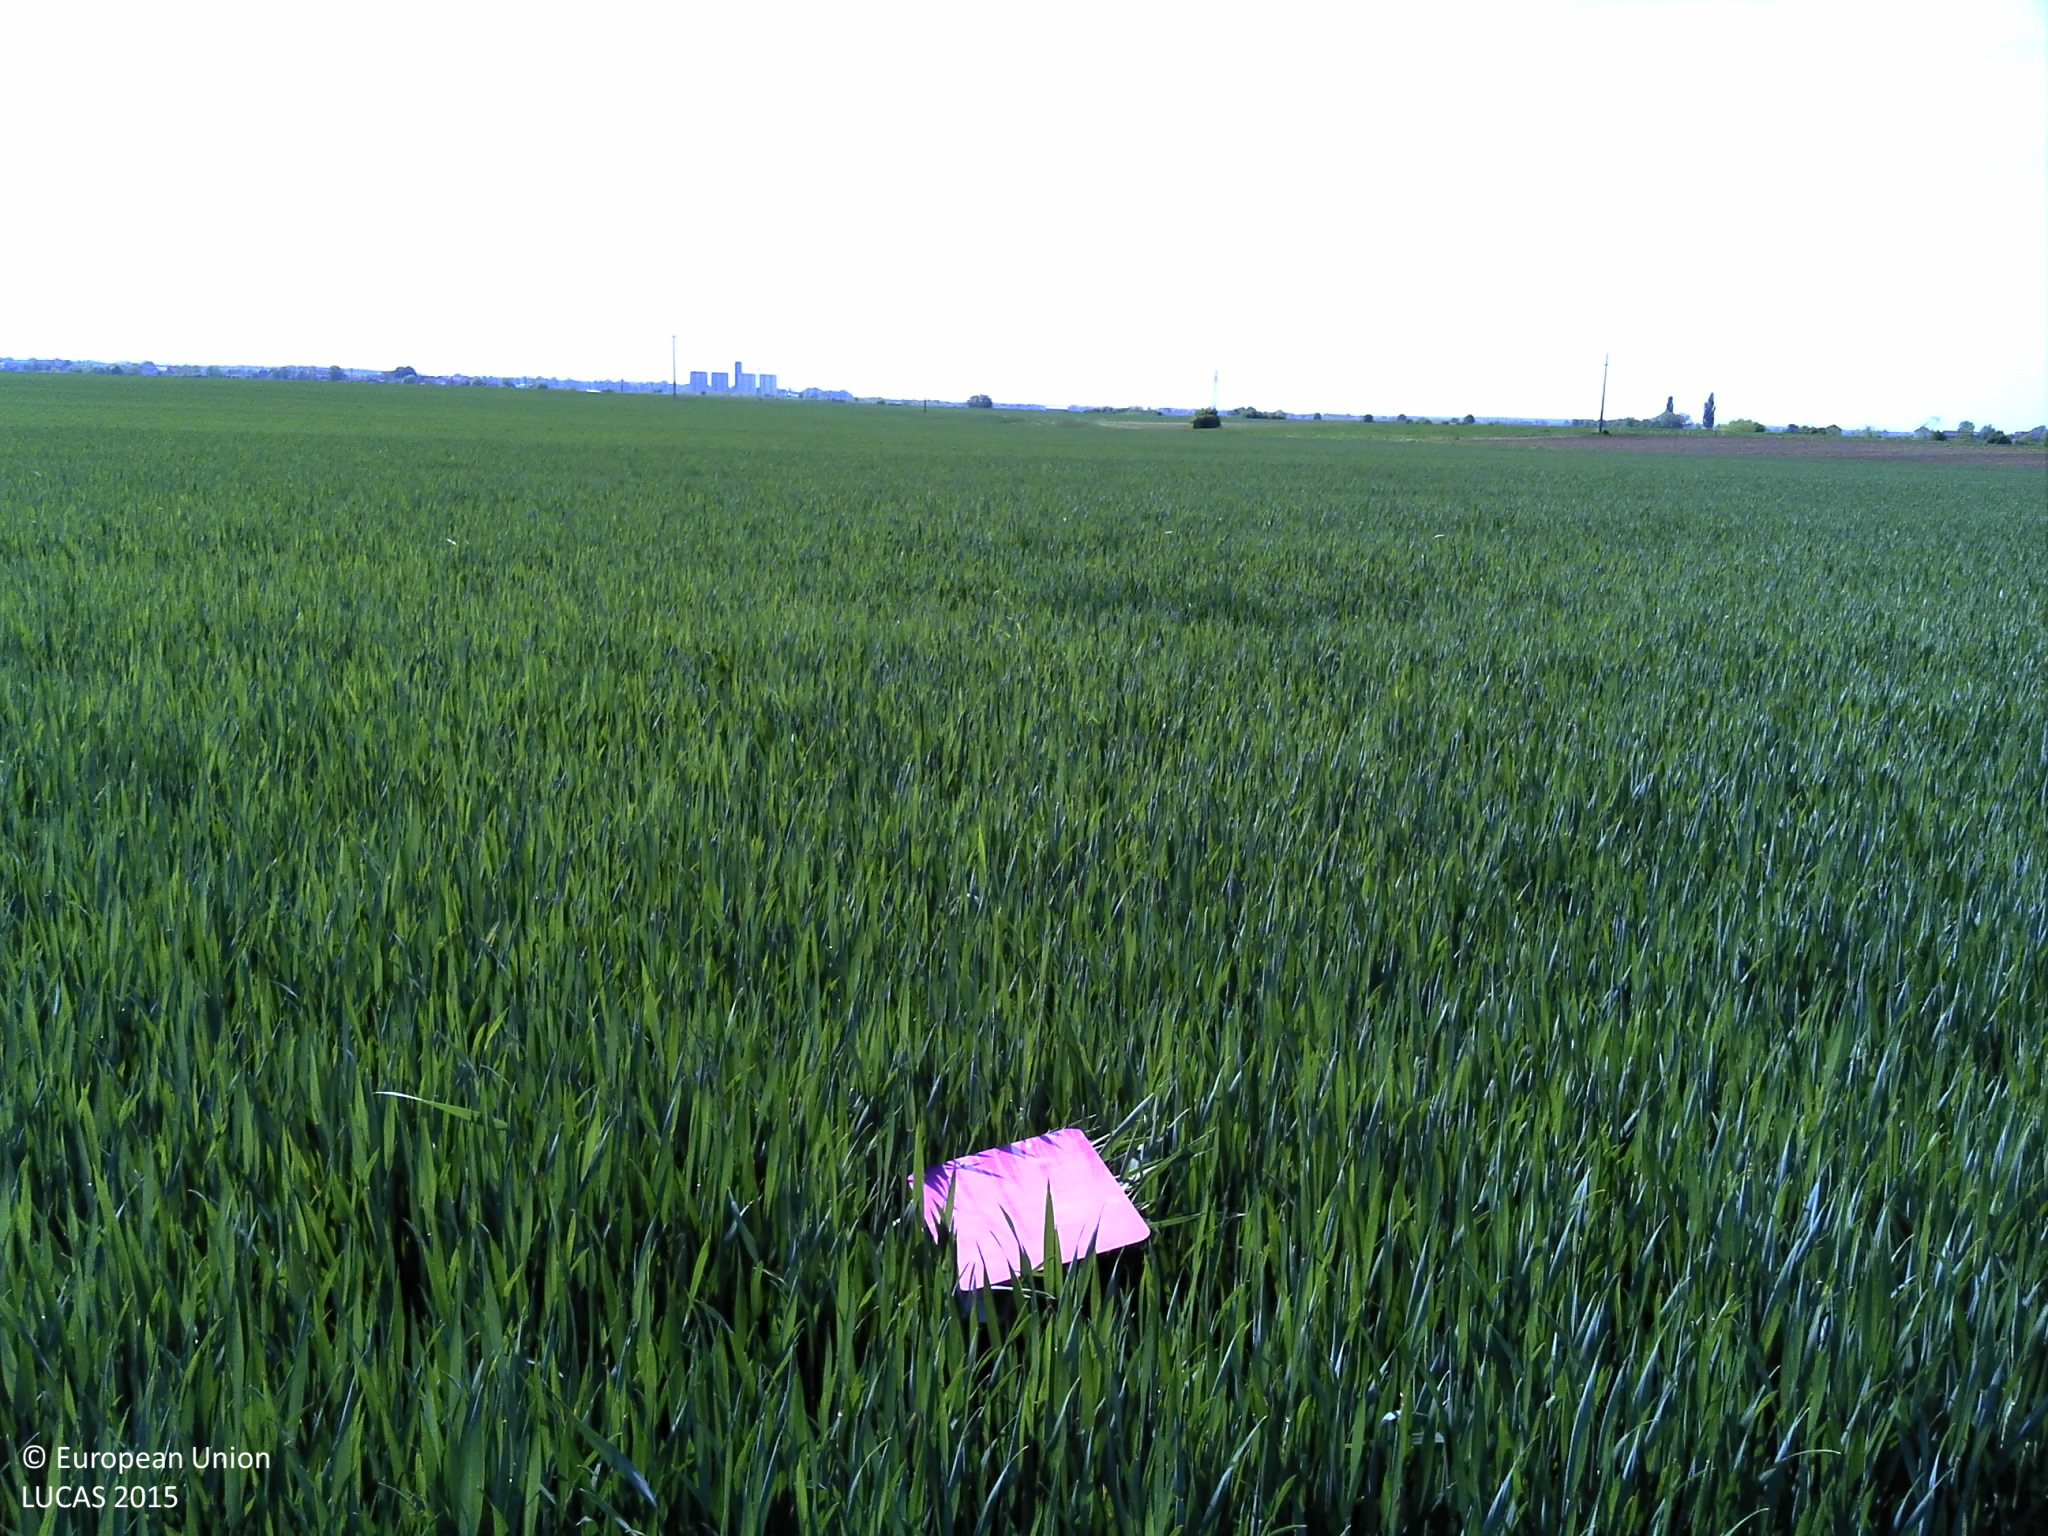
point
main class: Cropland
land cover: Common wheat
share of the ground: > 75 %
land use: Agriculture (excluding fallow land and kitchen gardens)
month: May
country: HR
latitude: 45.3987
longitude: 18.9124
